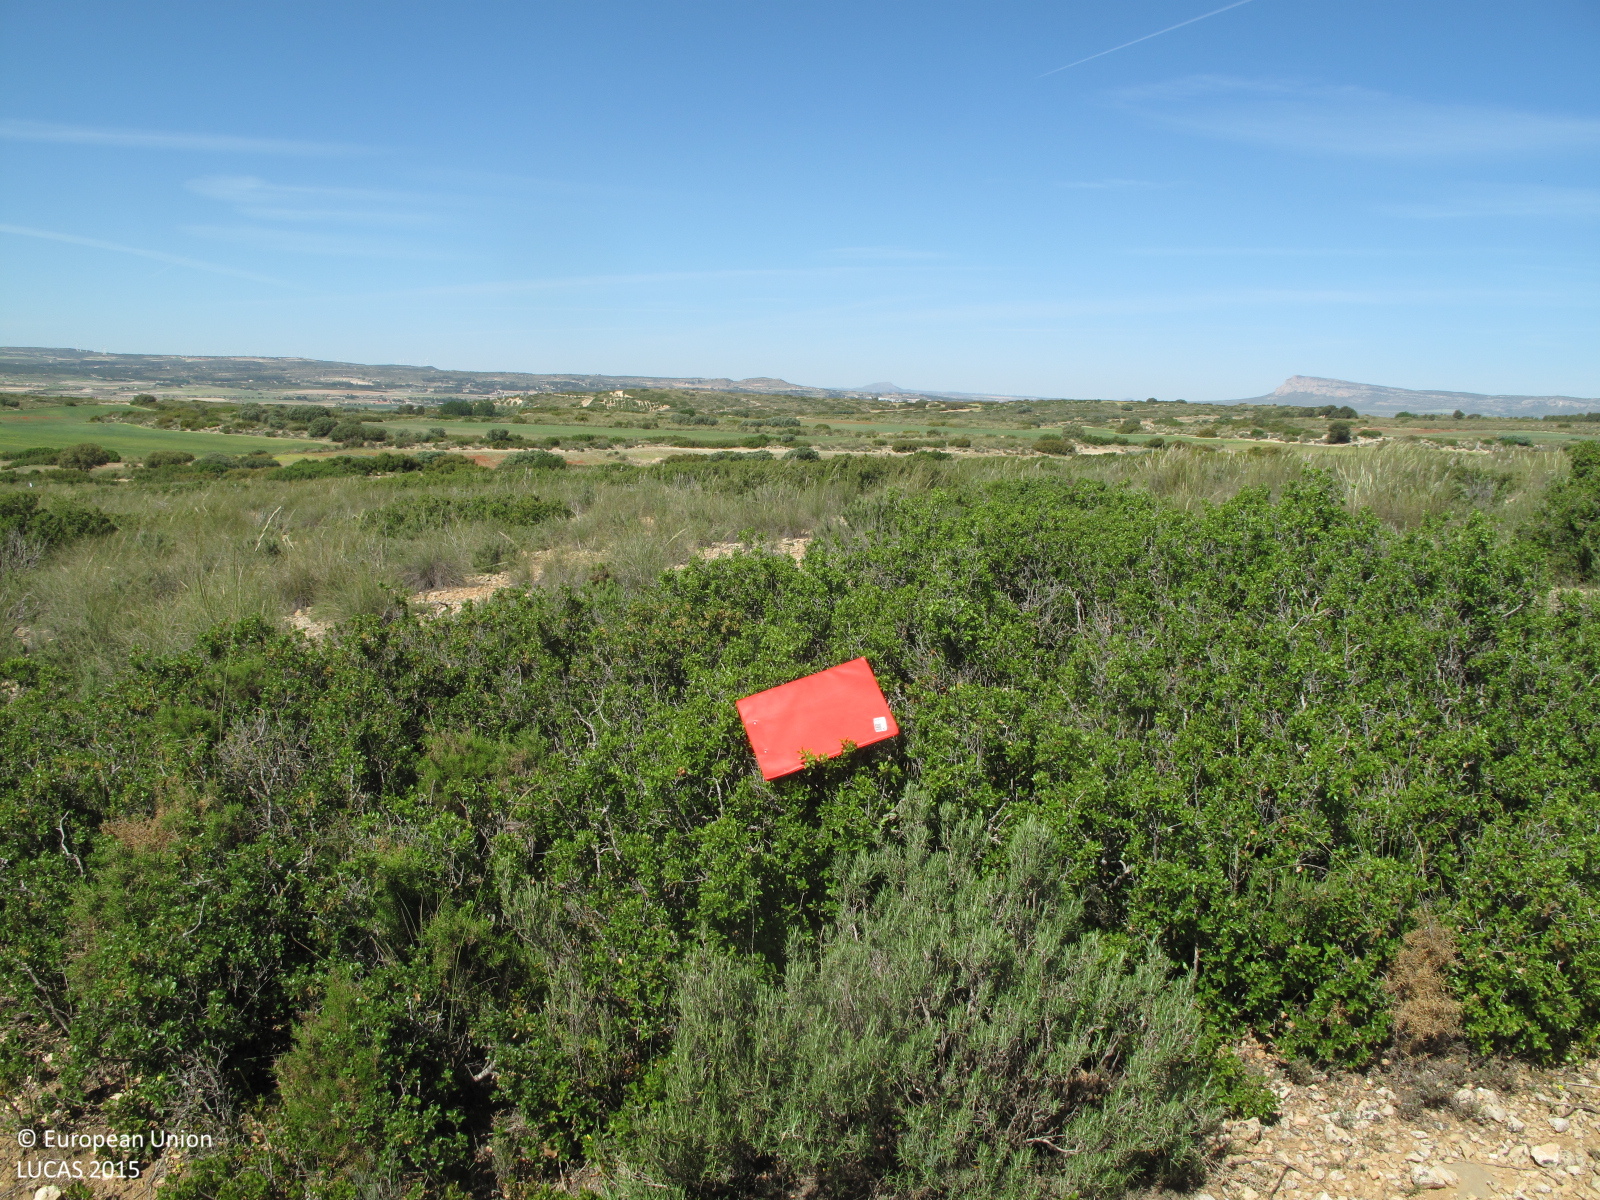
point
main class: Shrubland
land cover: Shrubland with sparse tree cover
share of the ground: 25 - 50 %
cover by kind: consolidated bare surface 45 %, shrubs 40 %, herbaceous plants 10 %, broadleaved forest trees 5 %
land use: Semi-natural and natural areas not in use
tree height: > 5 m
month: May
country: ES
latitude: 38.8773
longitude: -1.0250
